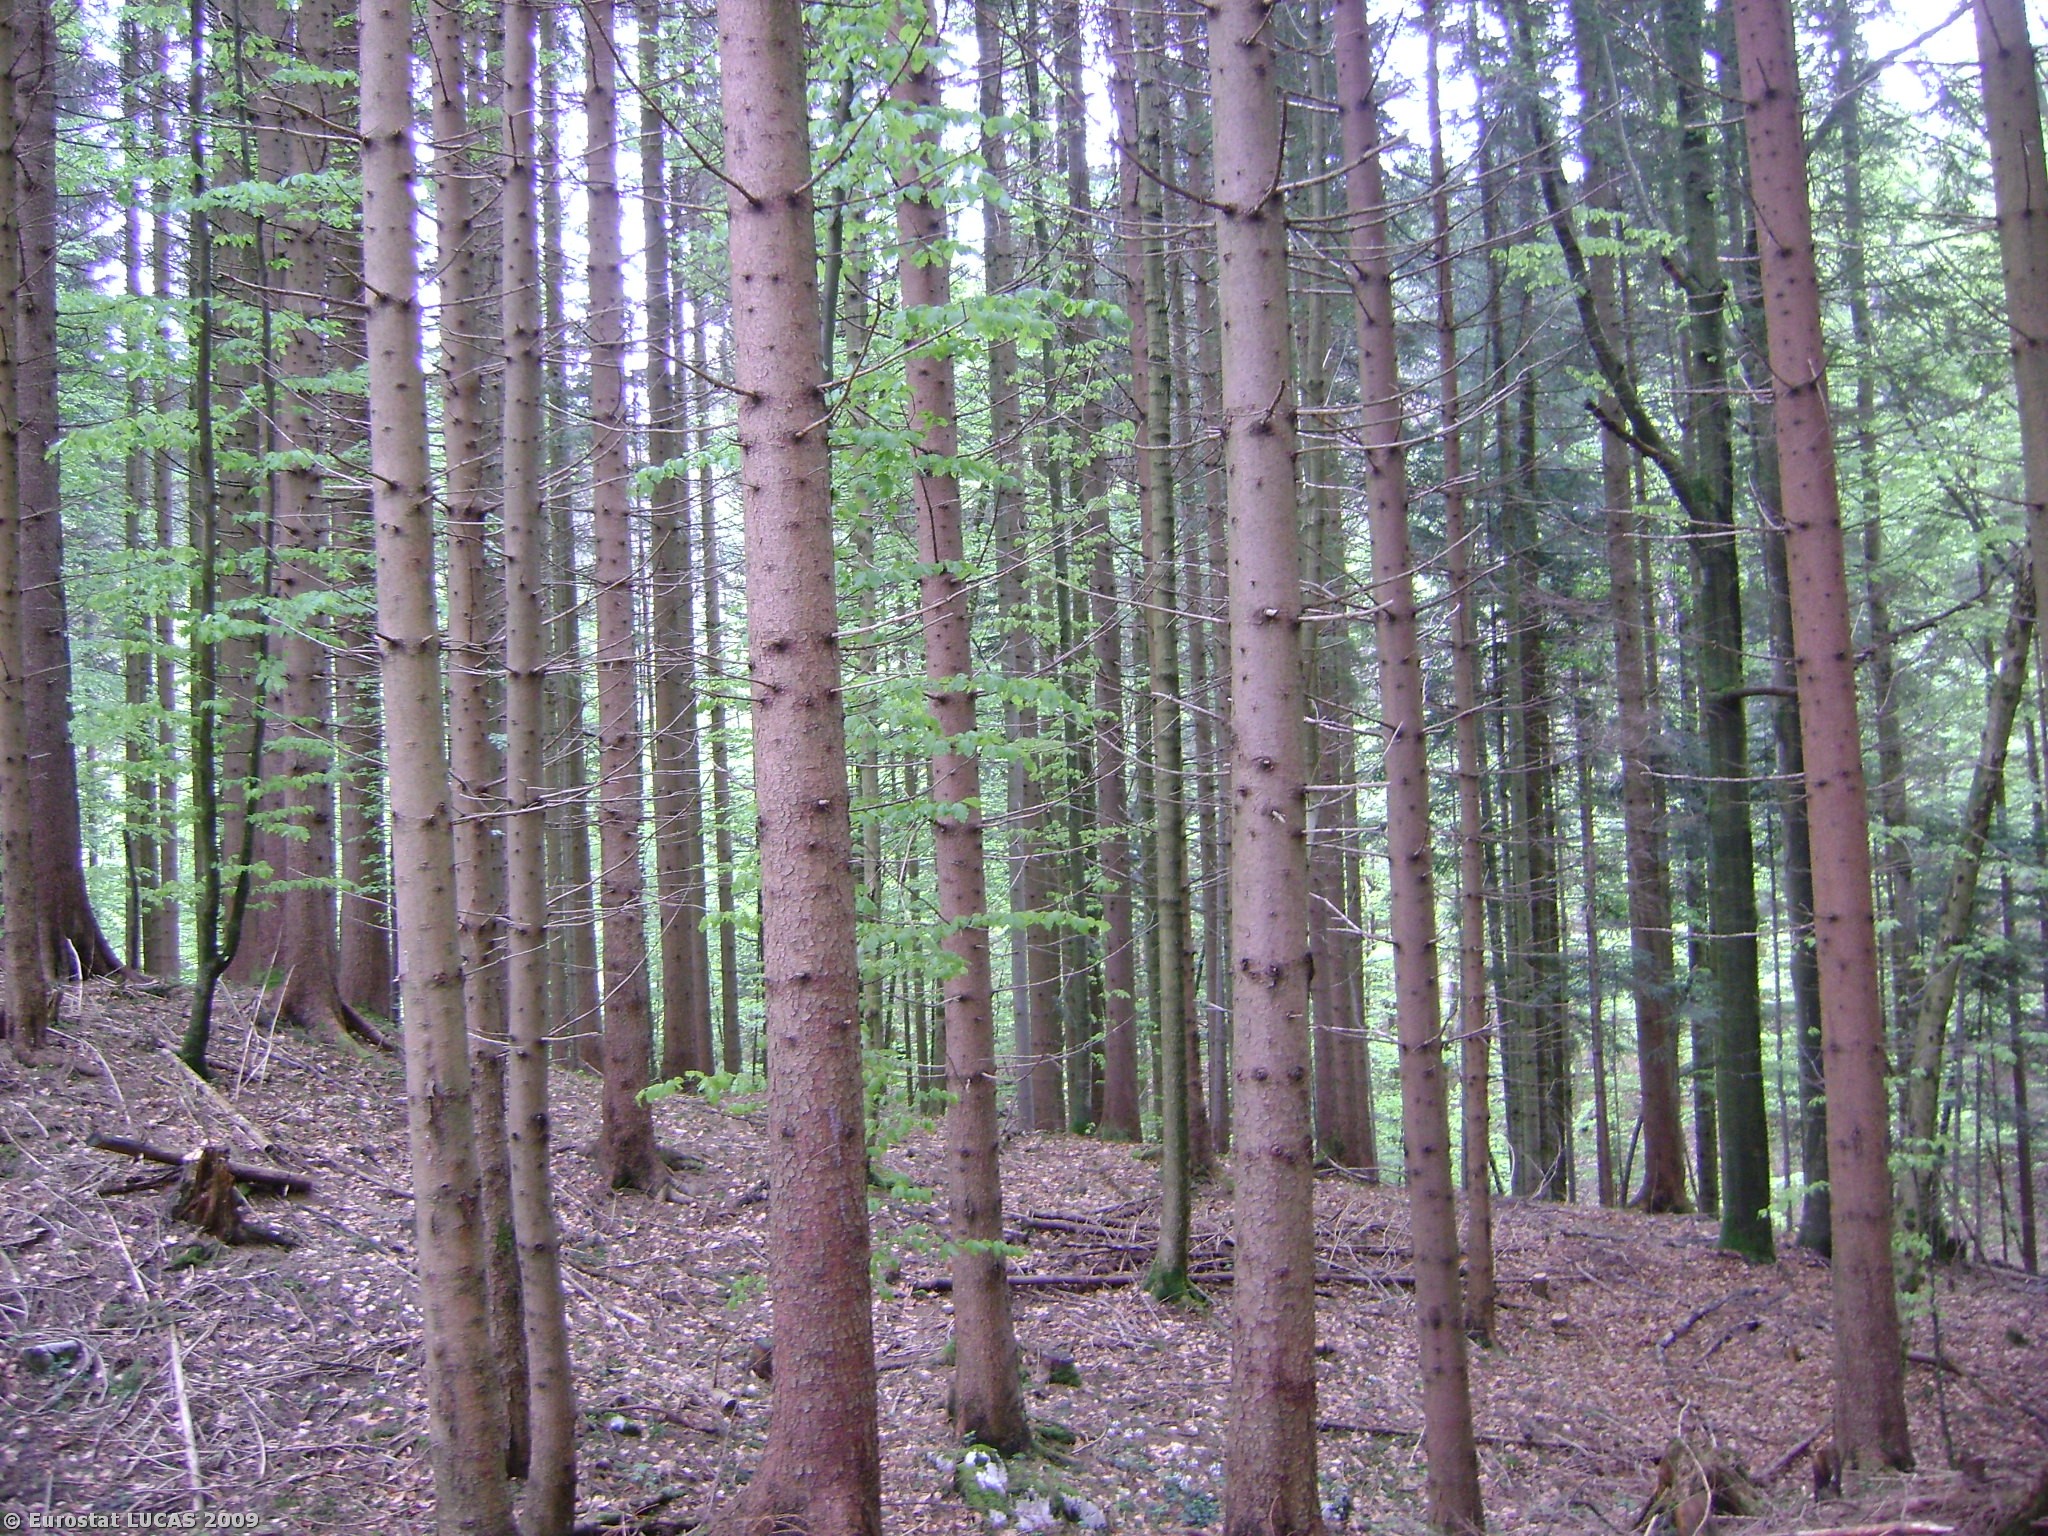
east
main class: Woodland
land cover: Mixed woodland
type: hemiboreal forest and nemoral coniferous forest and mixed broadleaved-coniferous forest
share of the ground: > 75 %
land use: Forestry
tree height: > 5 m
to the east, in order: Mixed woodland; Tracks; Mixed woodland; Ditches and canals; Mixed woodland; Coniferous woodland; Tracks; Coniferous woodland; Tracks; Coniferous woodland; Grassland without tree/shrub cover
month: May
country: AT
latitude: 47.7805
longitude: 13.2151
